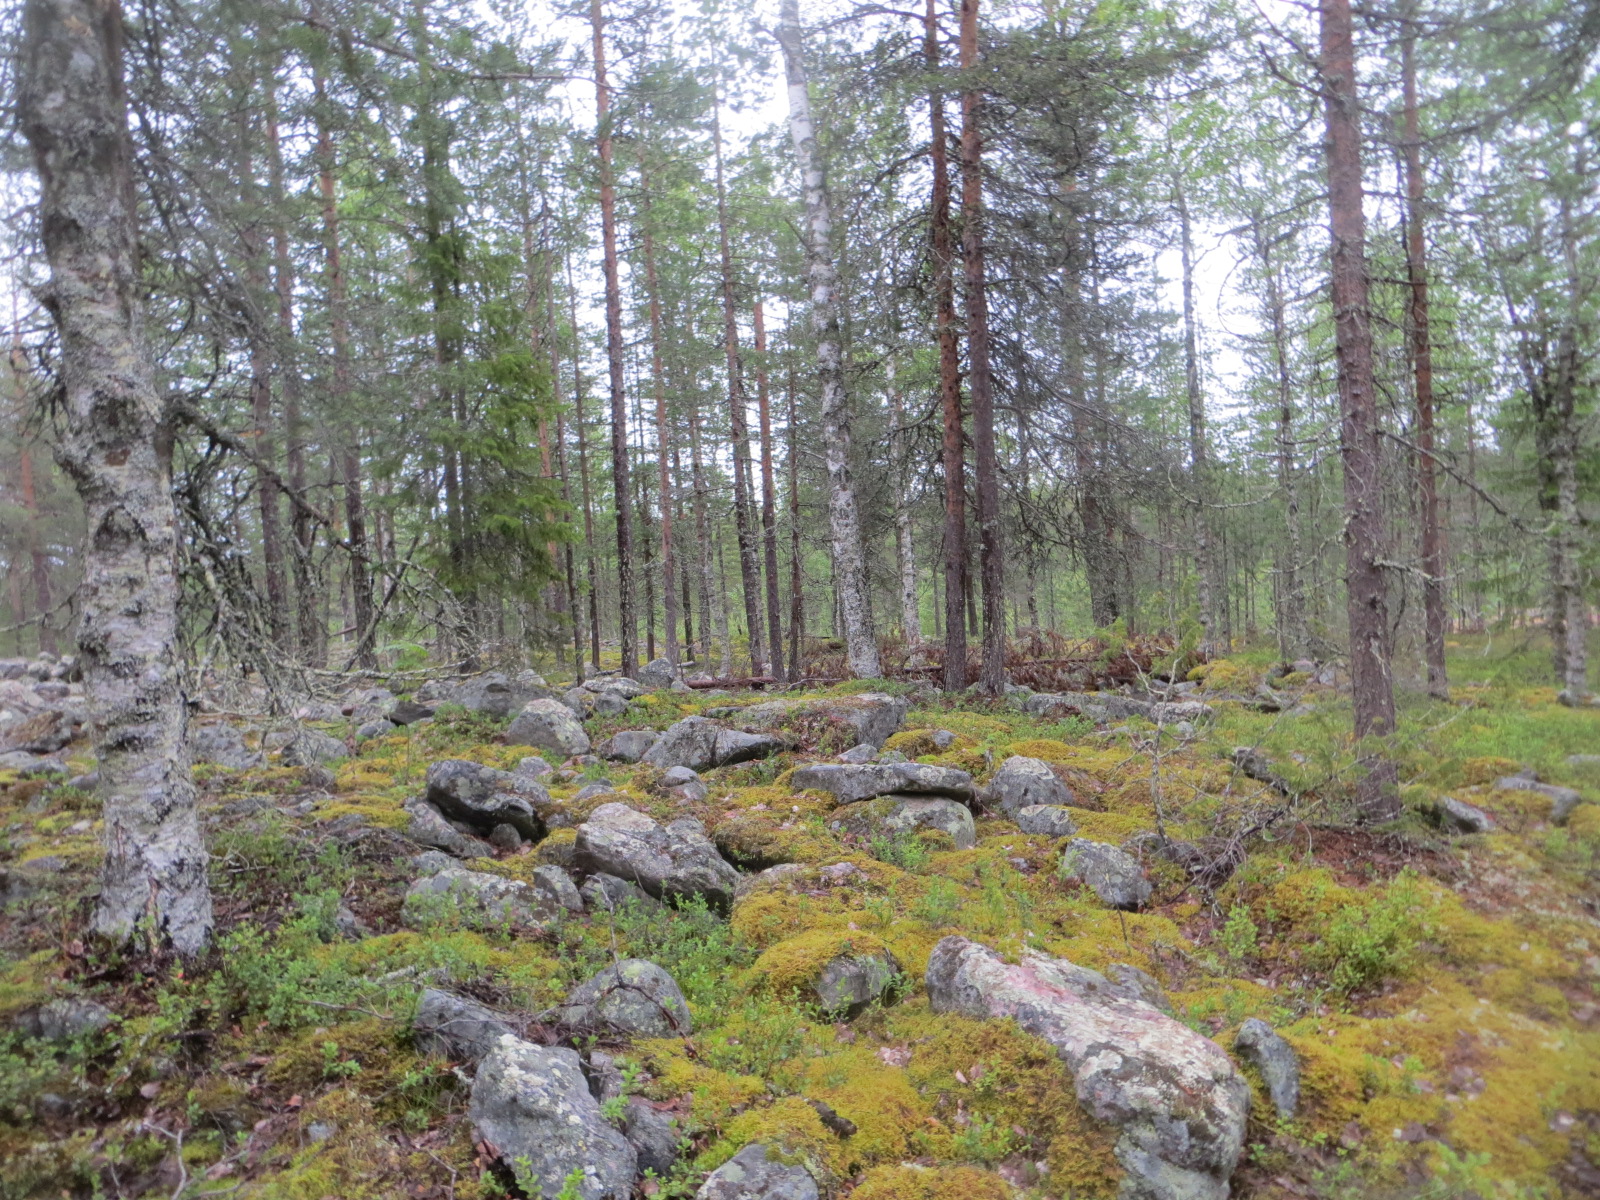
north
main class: Woodland
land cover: Pine dominated mixed woodland
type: boreal forest
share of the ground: 50 - 75 %
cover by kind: coniferous forest trees 40 %, broadleaved forest trees 30 %, shrubs 20 %, unconsolidated bare surface 10 %
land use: Forestry
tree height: > 5 m
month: July
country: FI
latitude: 66.5139
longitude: 24.5033
